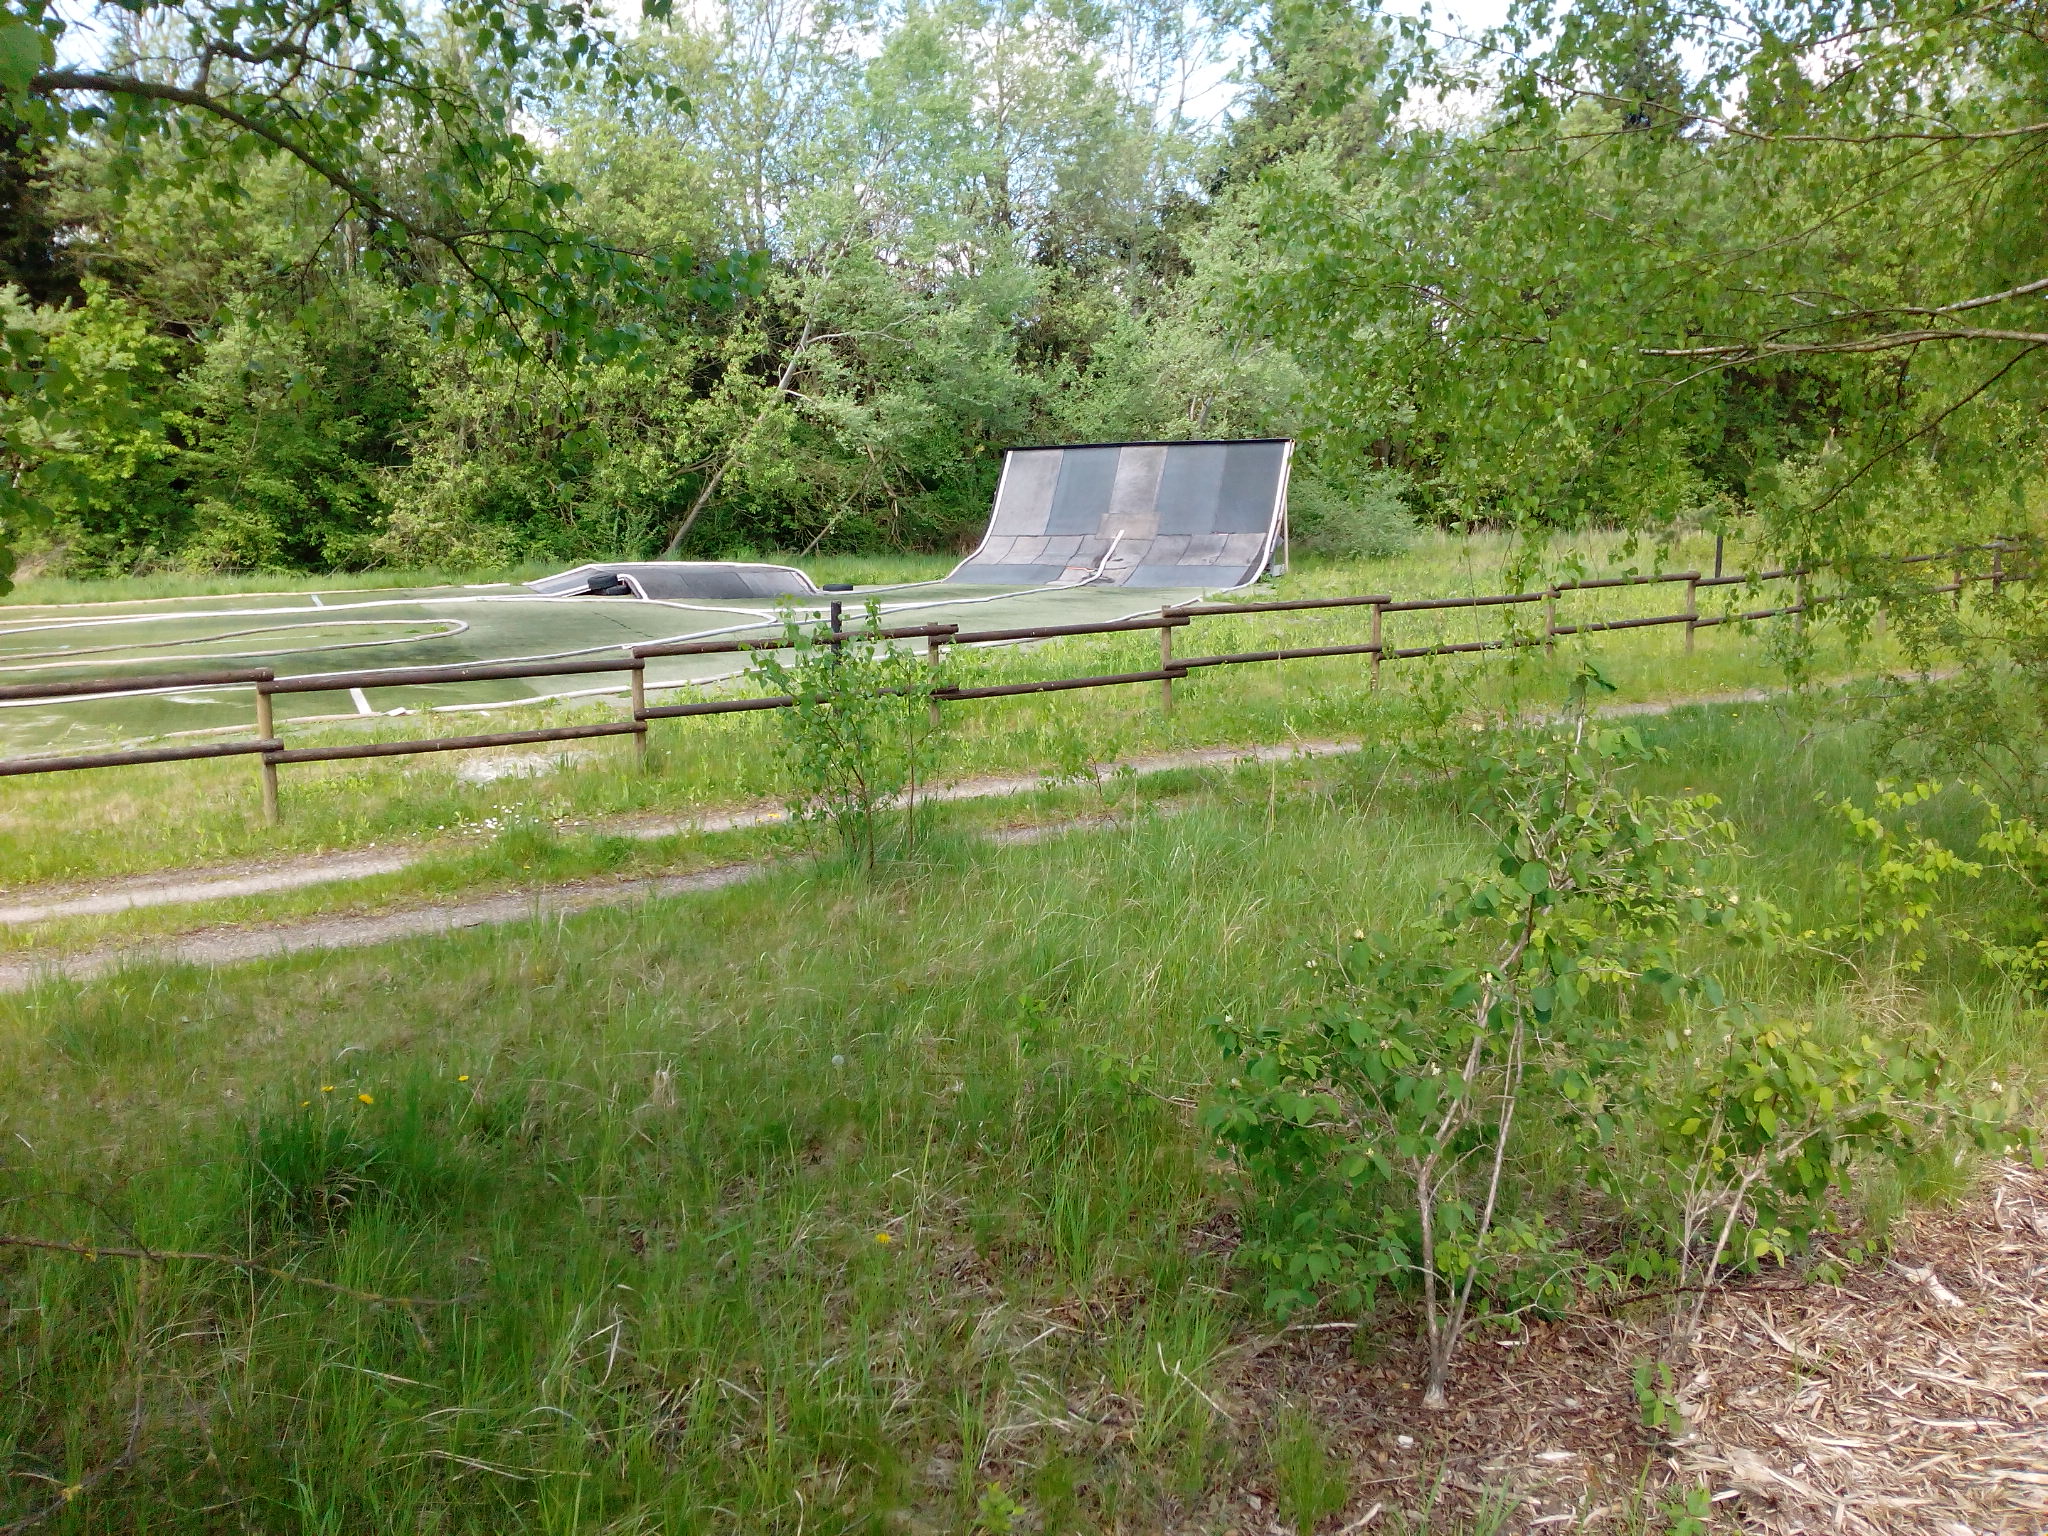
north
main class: Woodland
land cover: Broadleaved woodland
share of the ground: 50 - 75 %
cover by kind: broadleaved forest trees 70 %, herbaceous plants 15 %, consolidated bare surface 15 %
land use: Road transport
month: May
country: DE
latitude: 52.4493
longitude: 9.9265
